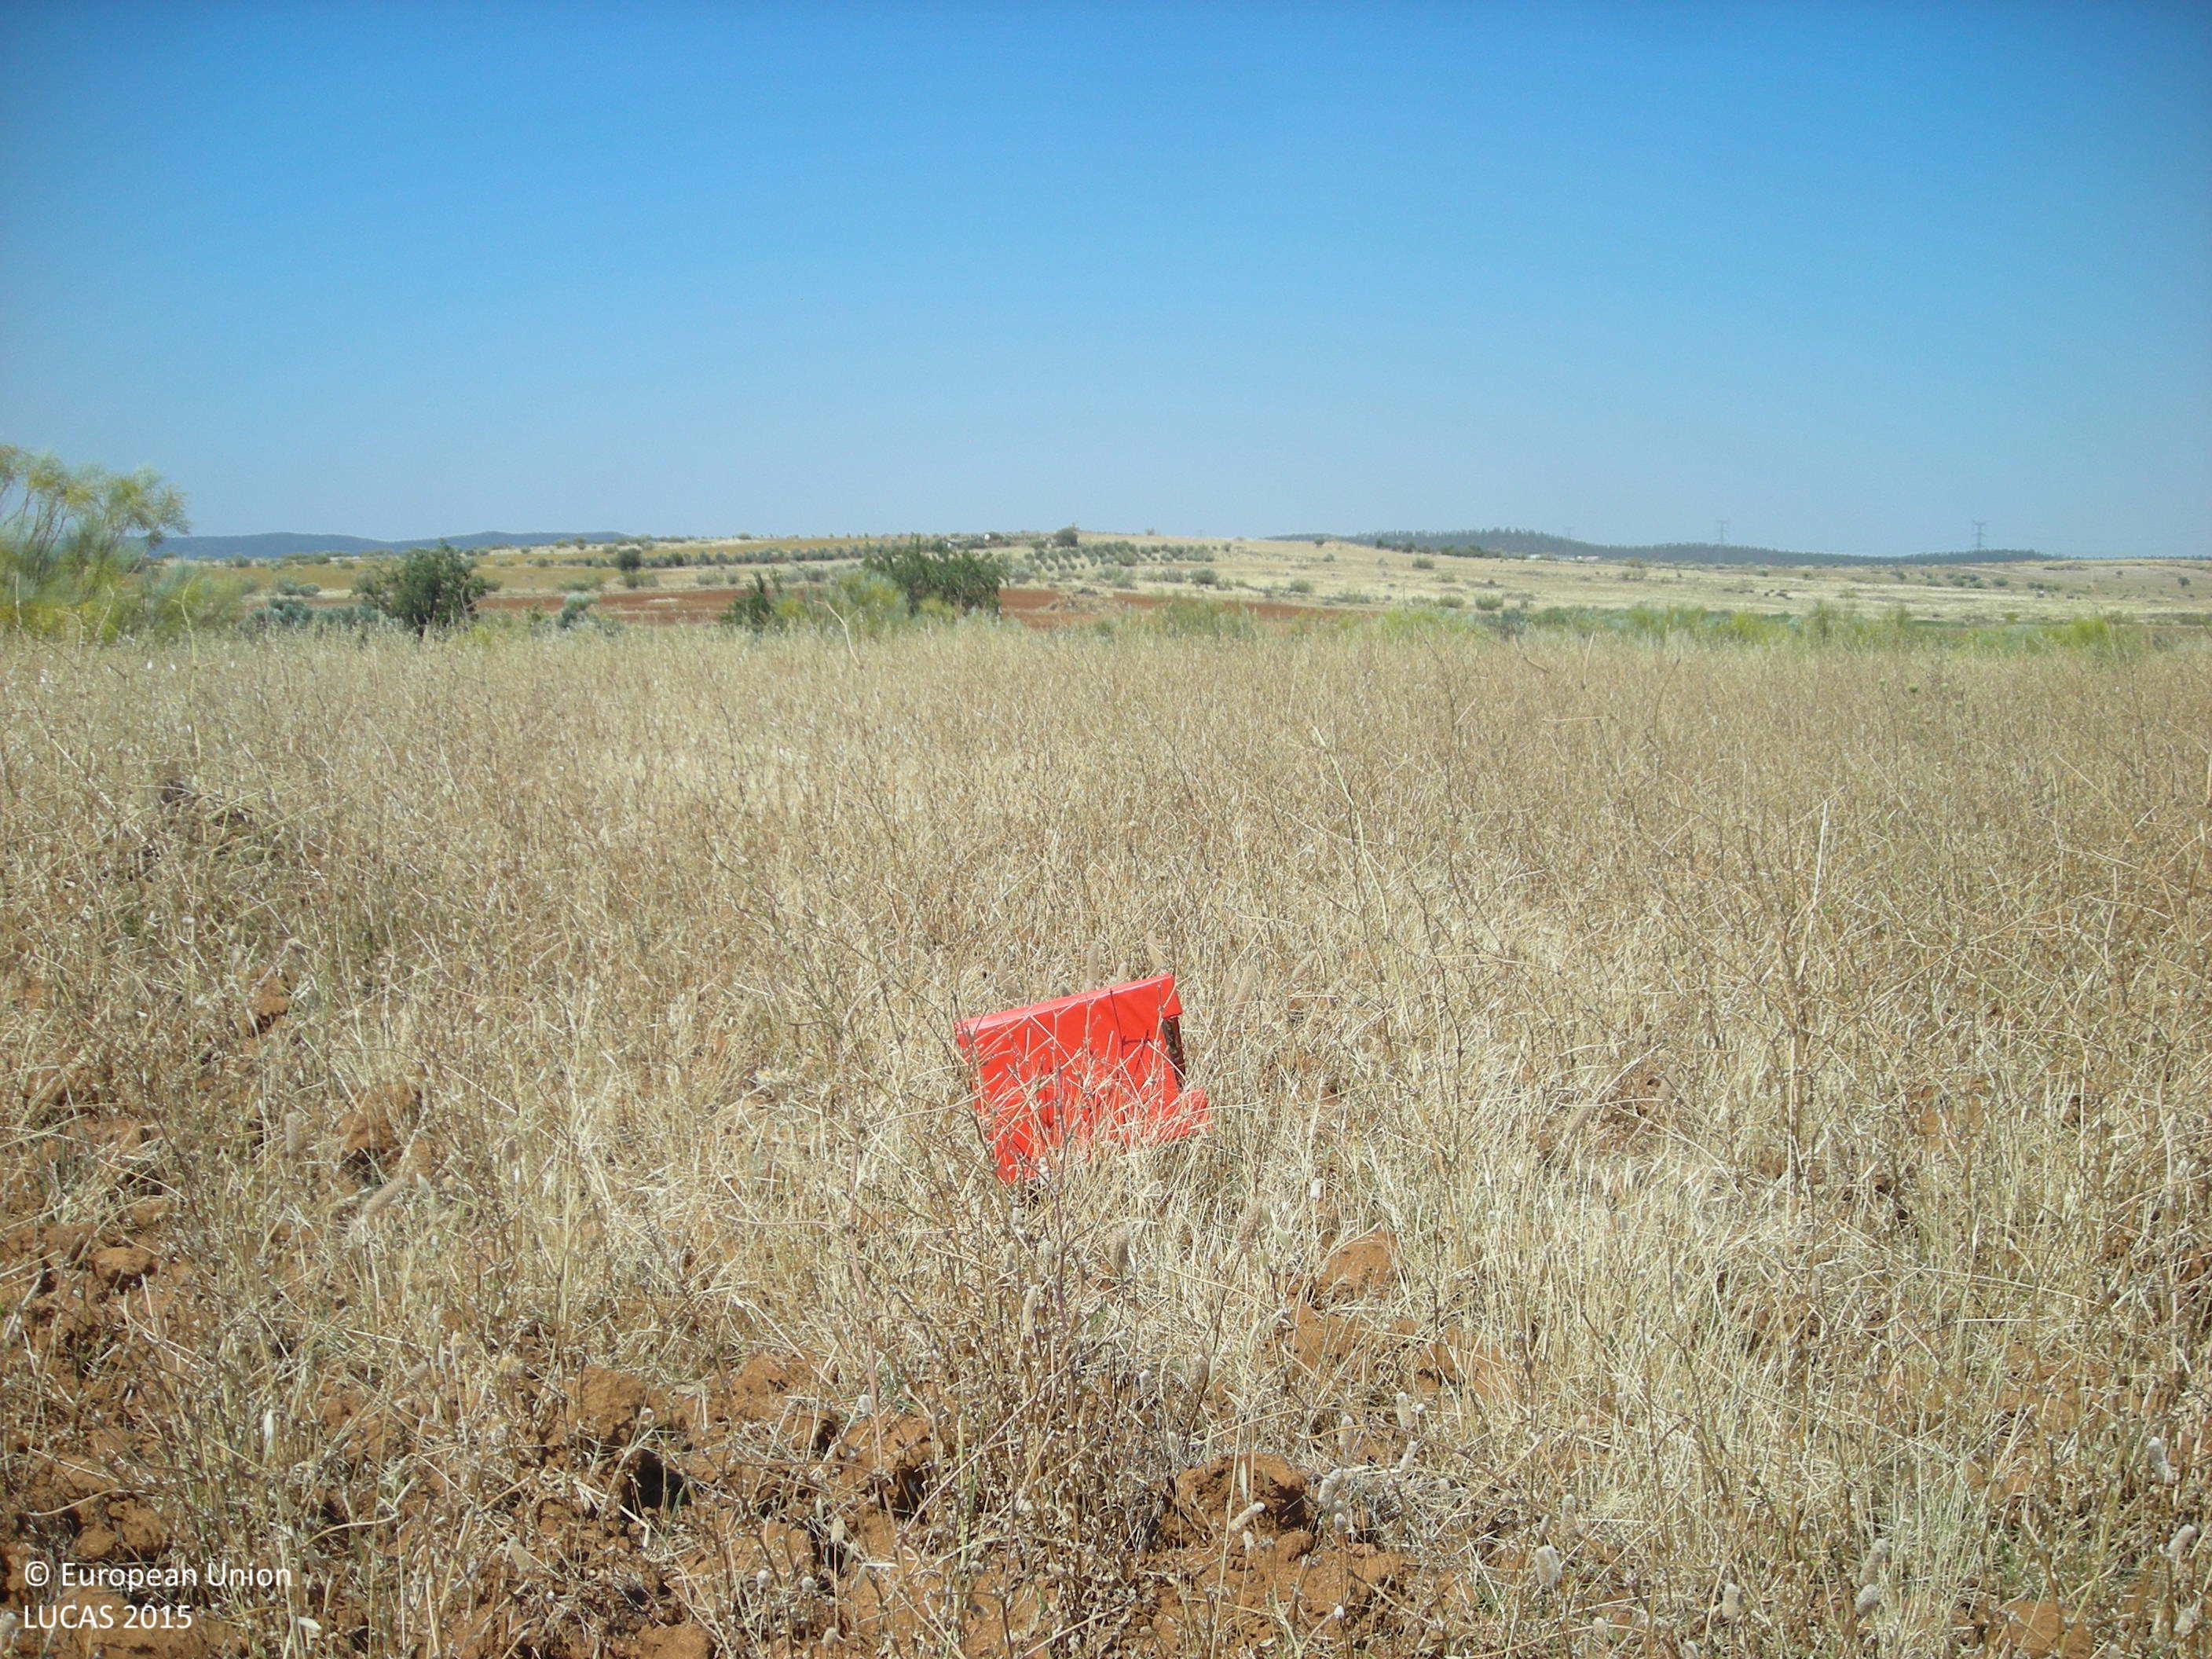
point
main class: Grassland
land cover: Grassland without tree/shrub cover
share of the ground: > 75 %
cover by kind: herbaceous plants 100 %
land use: Agriculture (excluding fallow land and kitchen gardens)
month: June
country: ES
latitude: 38.6512
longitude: -5.7730
